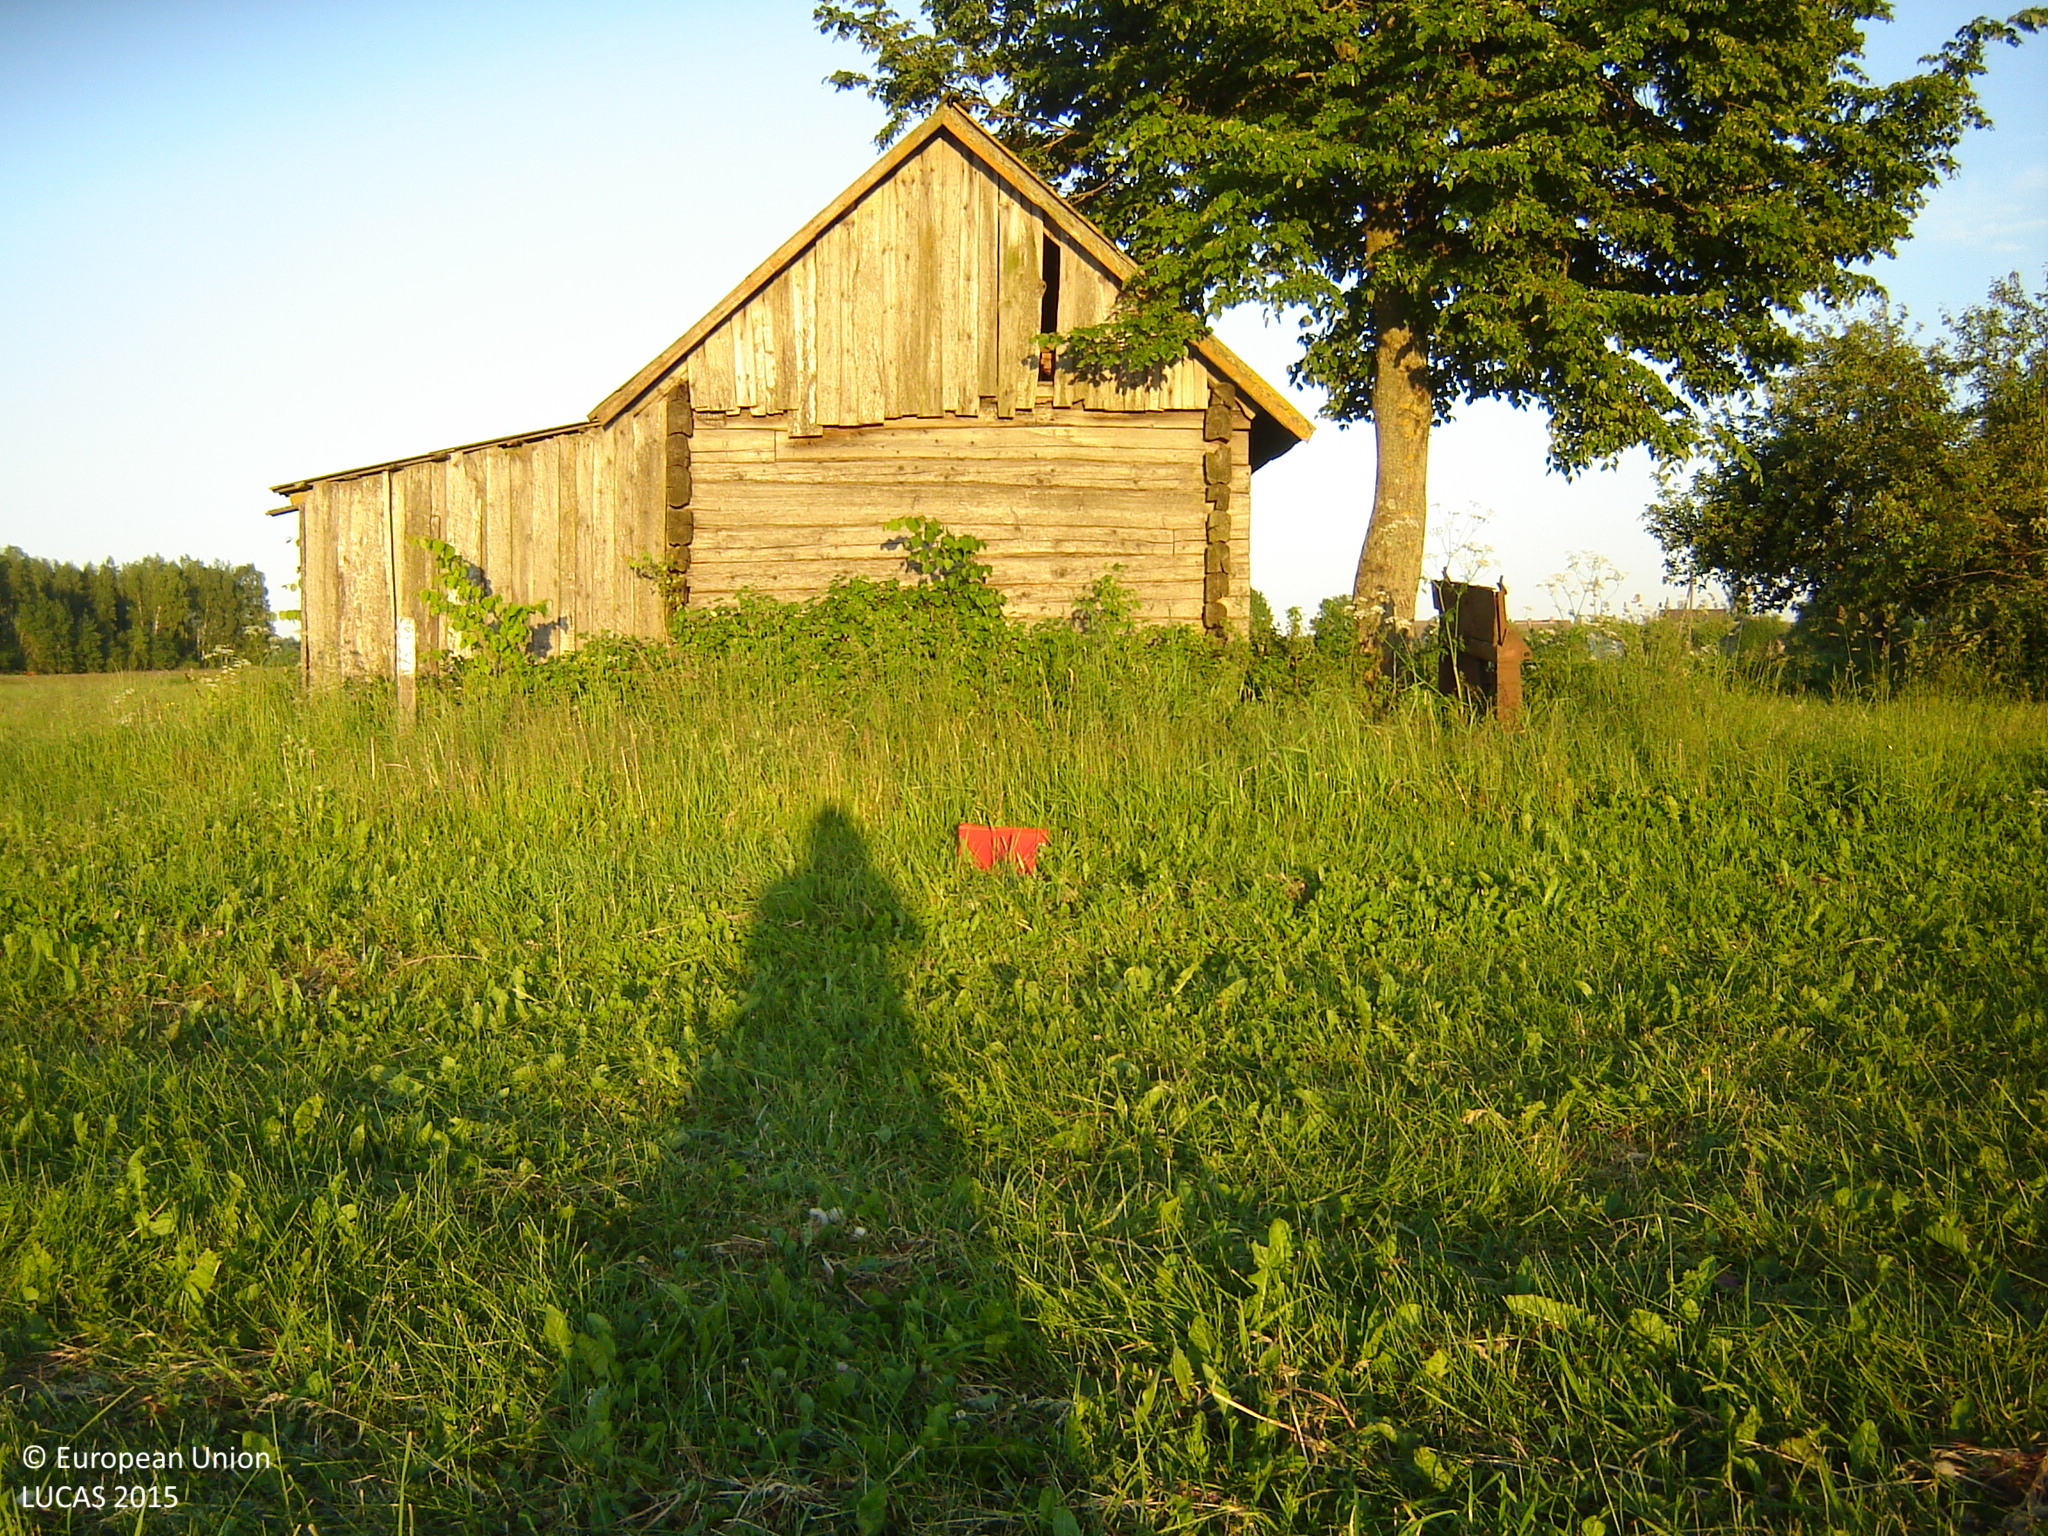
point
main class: Grassland
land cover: Grassland without tree/shrub cover
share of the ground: > 75 %
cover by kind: herbaceous plants 100 %
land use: Agriculture (excluding fallow land and kitchen gardens)
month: June
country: LT
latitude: 55.5819
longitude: 25.2354
